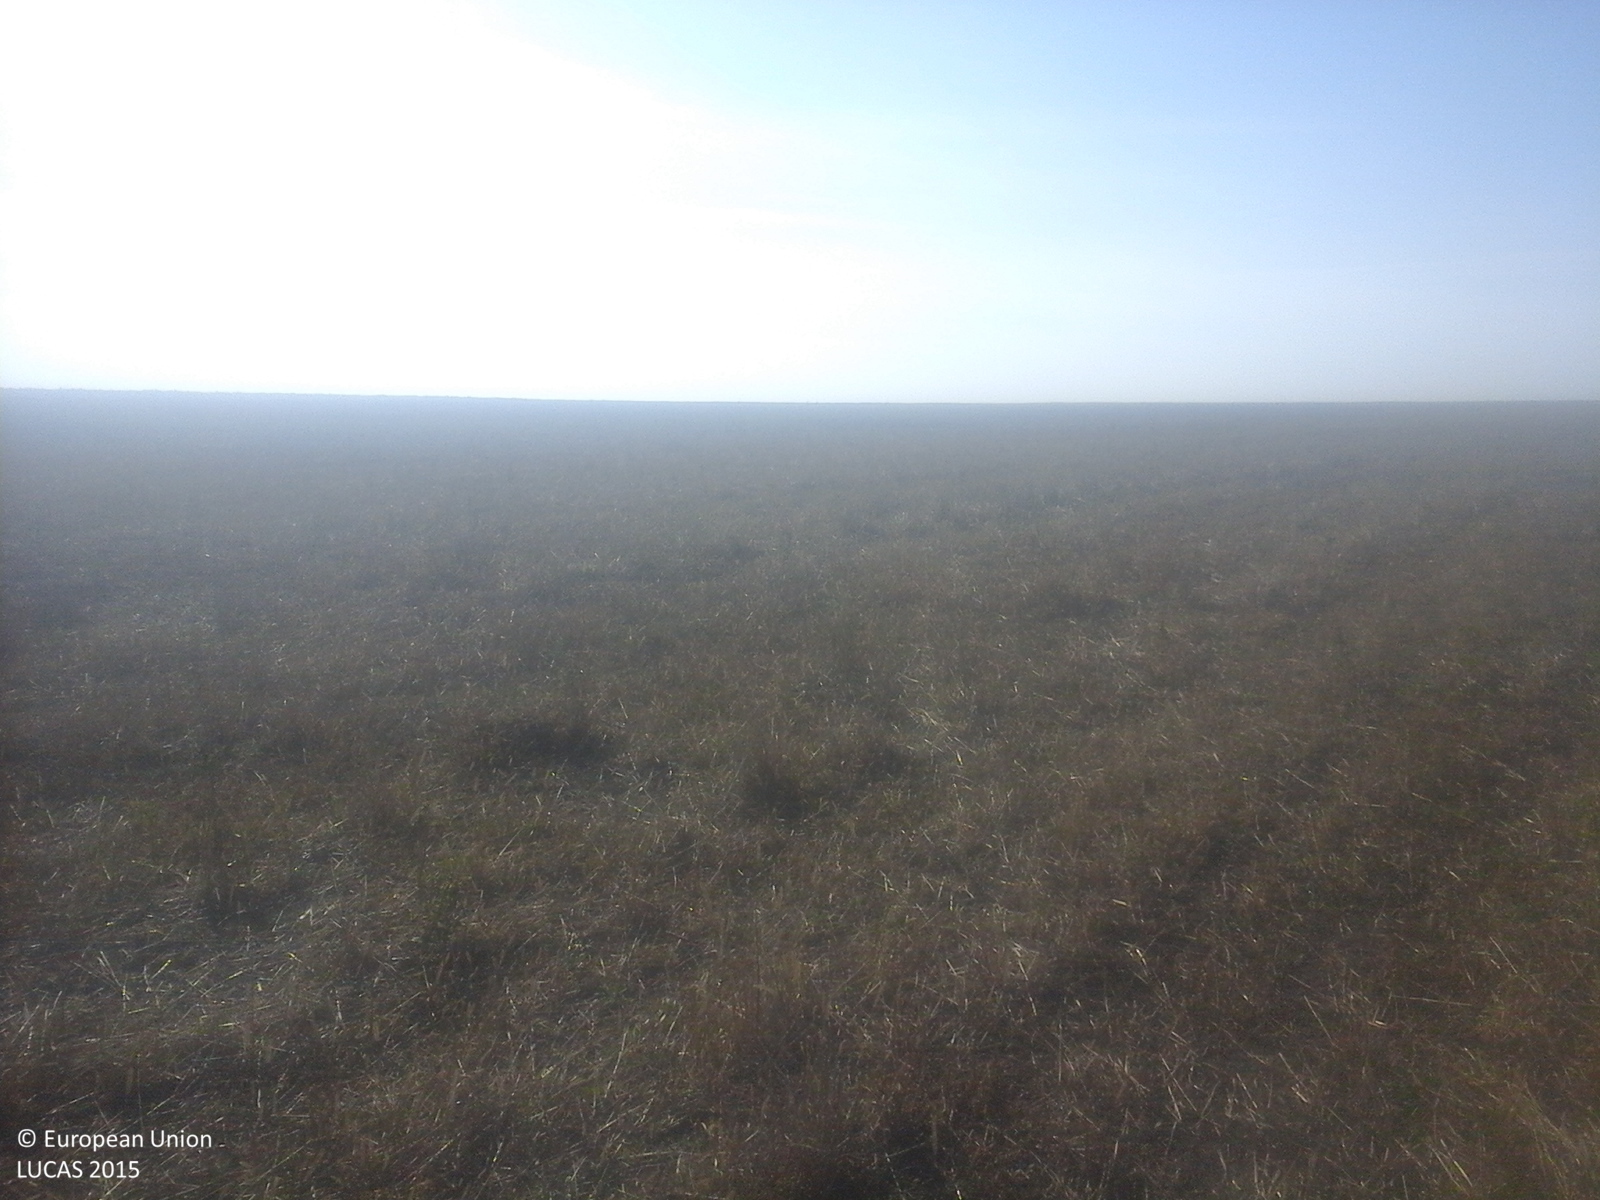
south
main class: Cropland
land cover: Common wheat
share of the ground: > 75 %
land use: Agriculture (excluding fallow land and kitchen gardens)
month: October
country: RO
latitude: 45.3149
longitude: 26.9613
